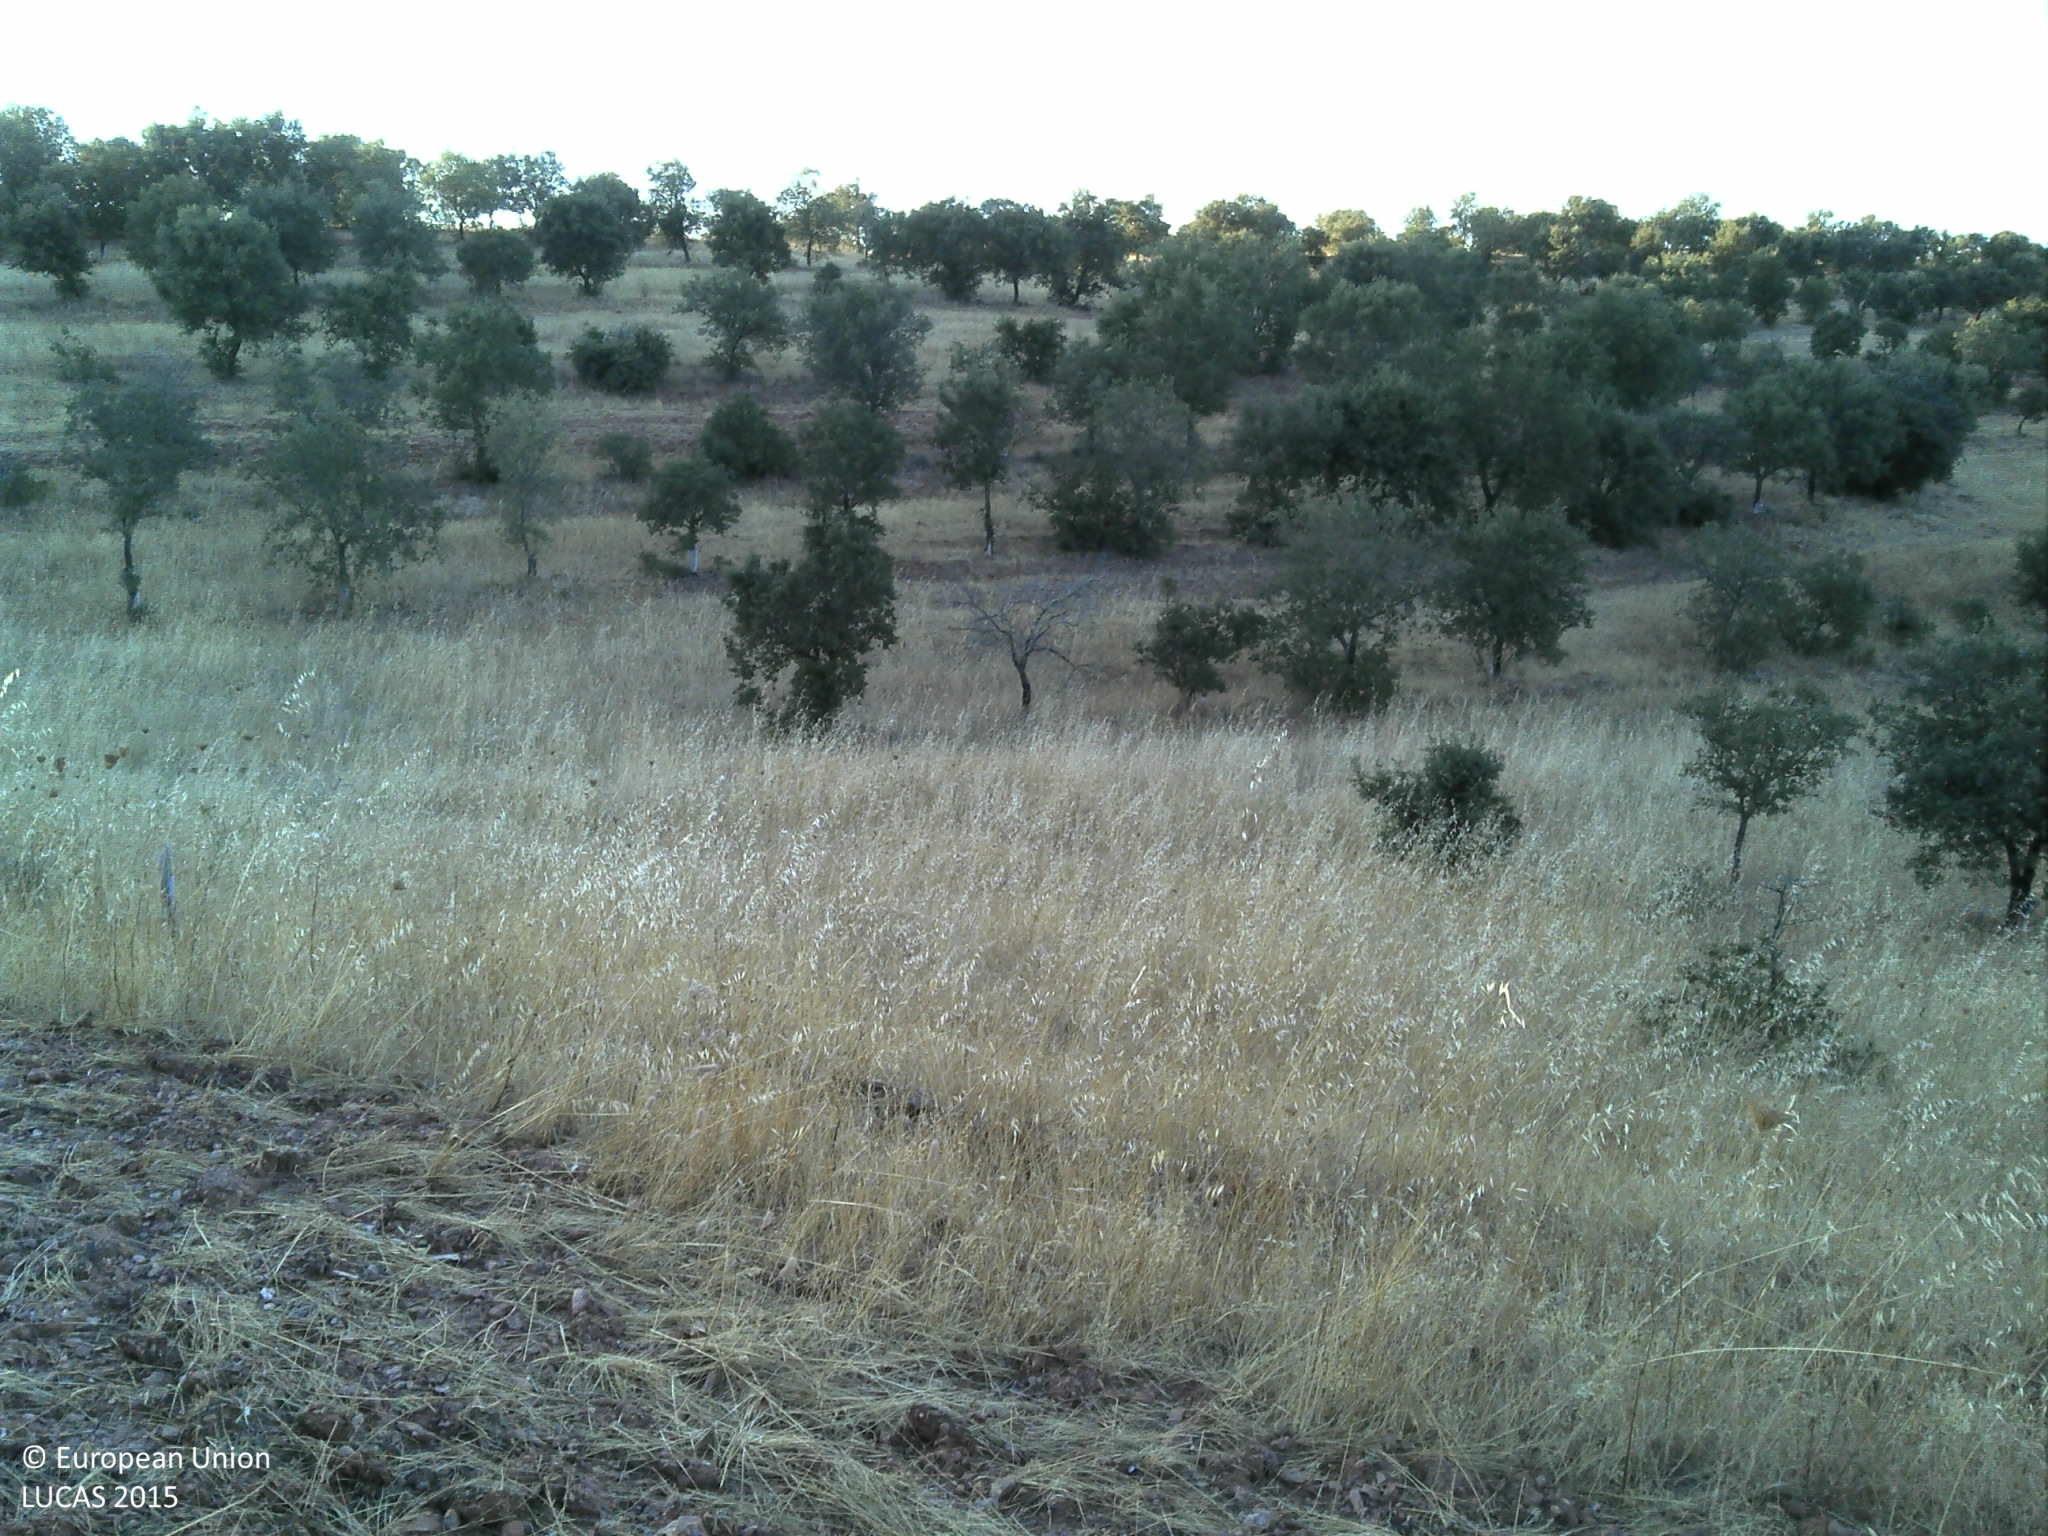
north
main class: Woodland
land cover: Broadleaved woodland
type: broadleaved evergreen forest
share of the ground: 25 - 50 %
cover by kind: broadleaved forest trees 50 %, herbaceous plants 30 %, unconsolidated bare surface 15 %
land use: Forestry
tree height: < 5 m
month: August
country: PT
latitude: 37.8602
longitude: -7.8351
